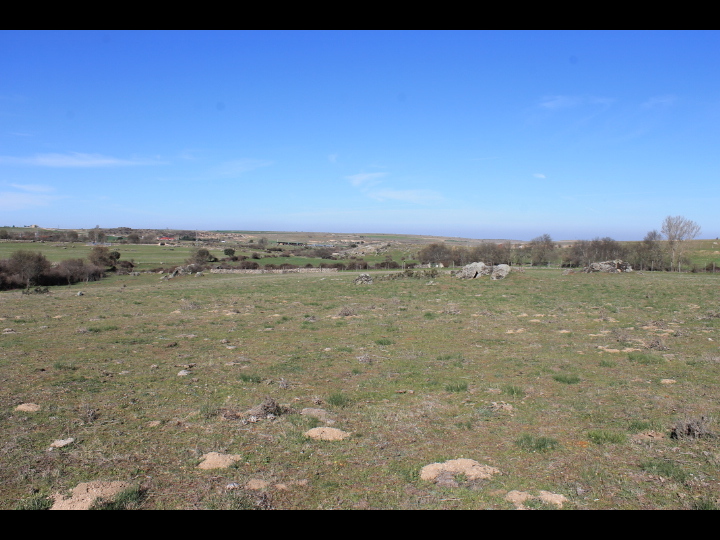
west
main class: Grassland
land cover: Grassland without tree/shrub cover
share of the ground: > 75 %
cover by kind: herbaceous plants 95 %, unconsolidated bare surface 5 %
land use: Agriculture (excluding fallow land and kitchen gardens)
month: April
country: ES
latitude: 40.9896
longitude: -4.0643
